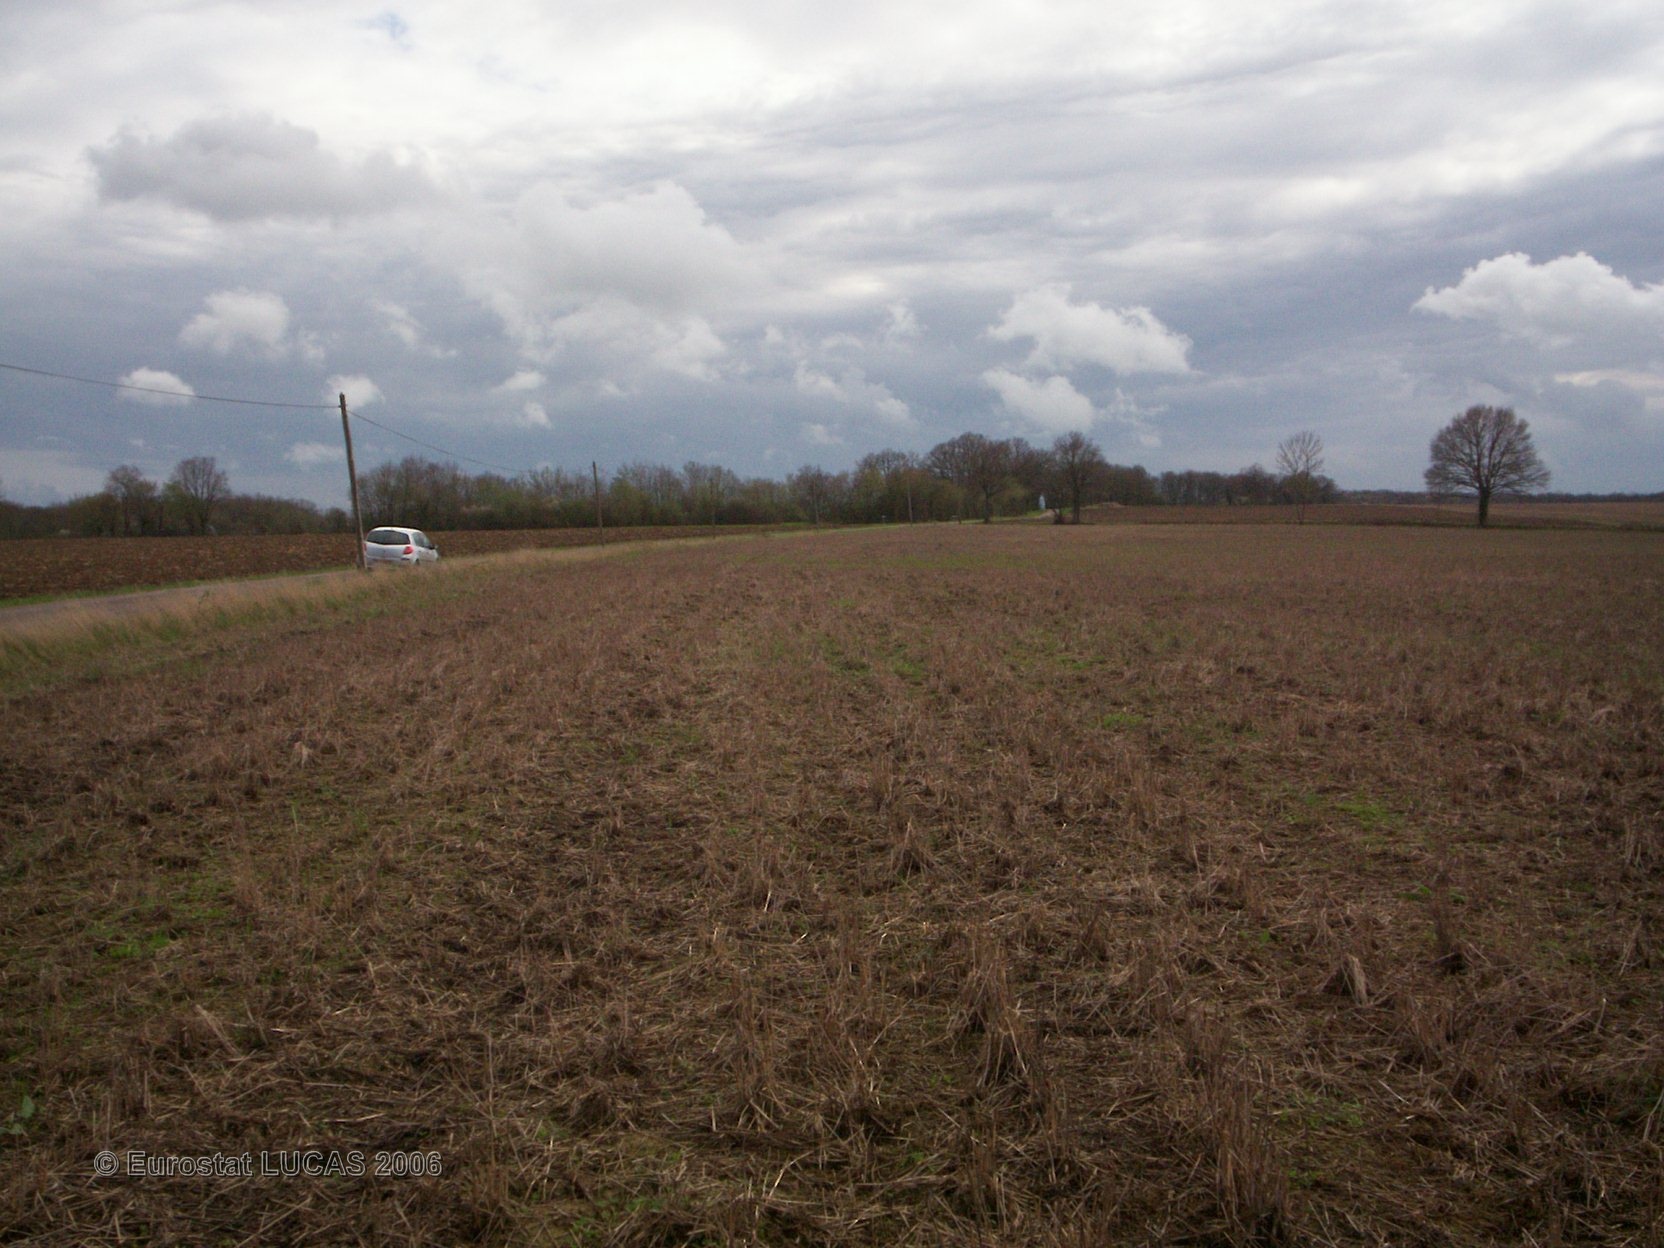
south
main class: Cropland
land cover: Other leguminous and mixtures for fodder
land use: Agriculture (excluding fallow land and kitchen gardens)
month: May
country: FR
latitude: 47.4772
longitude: 3.0013
